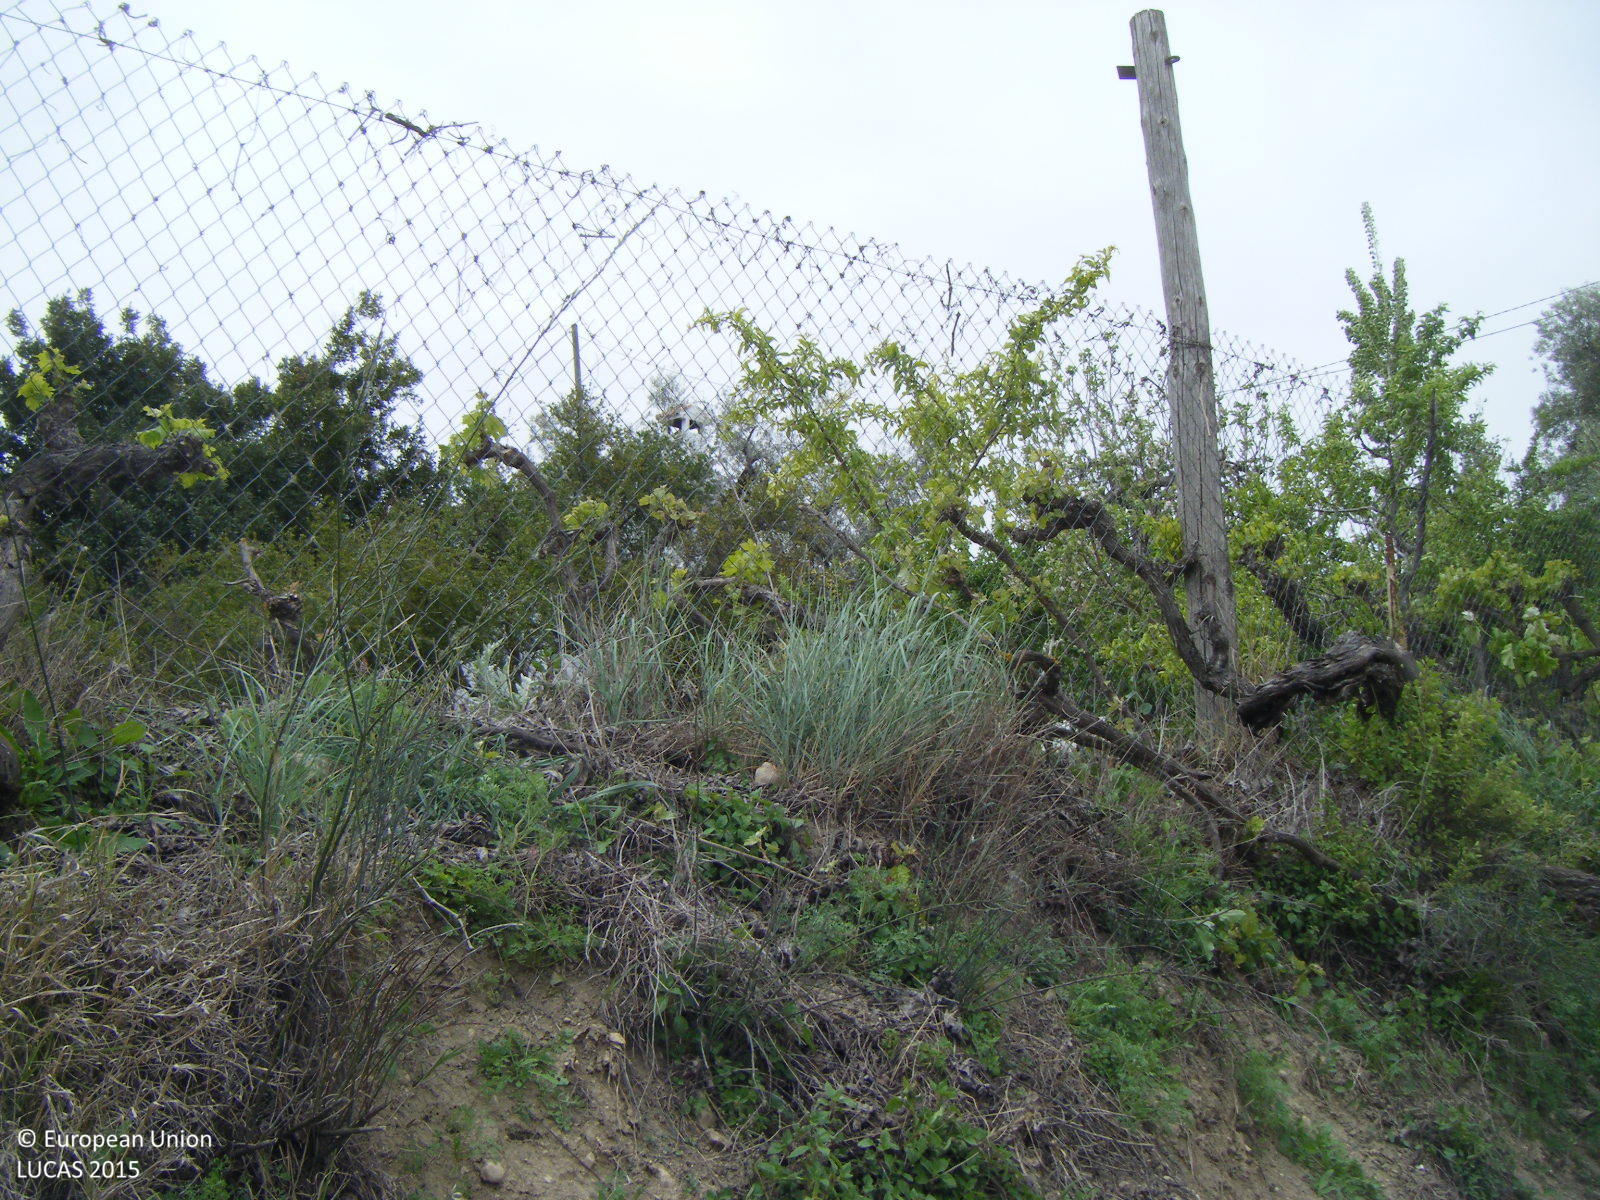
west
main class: Woodland
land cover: Broadleaved woodland
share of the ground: > 75 %
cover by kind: broadleaved forest trees 95 %, coniferous forest trees 5 %
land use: Residential
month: April
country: ES
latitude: 37.1761
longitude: -4.1752
